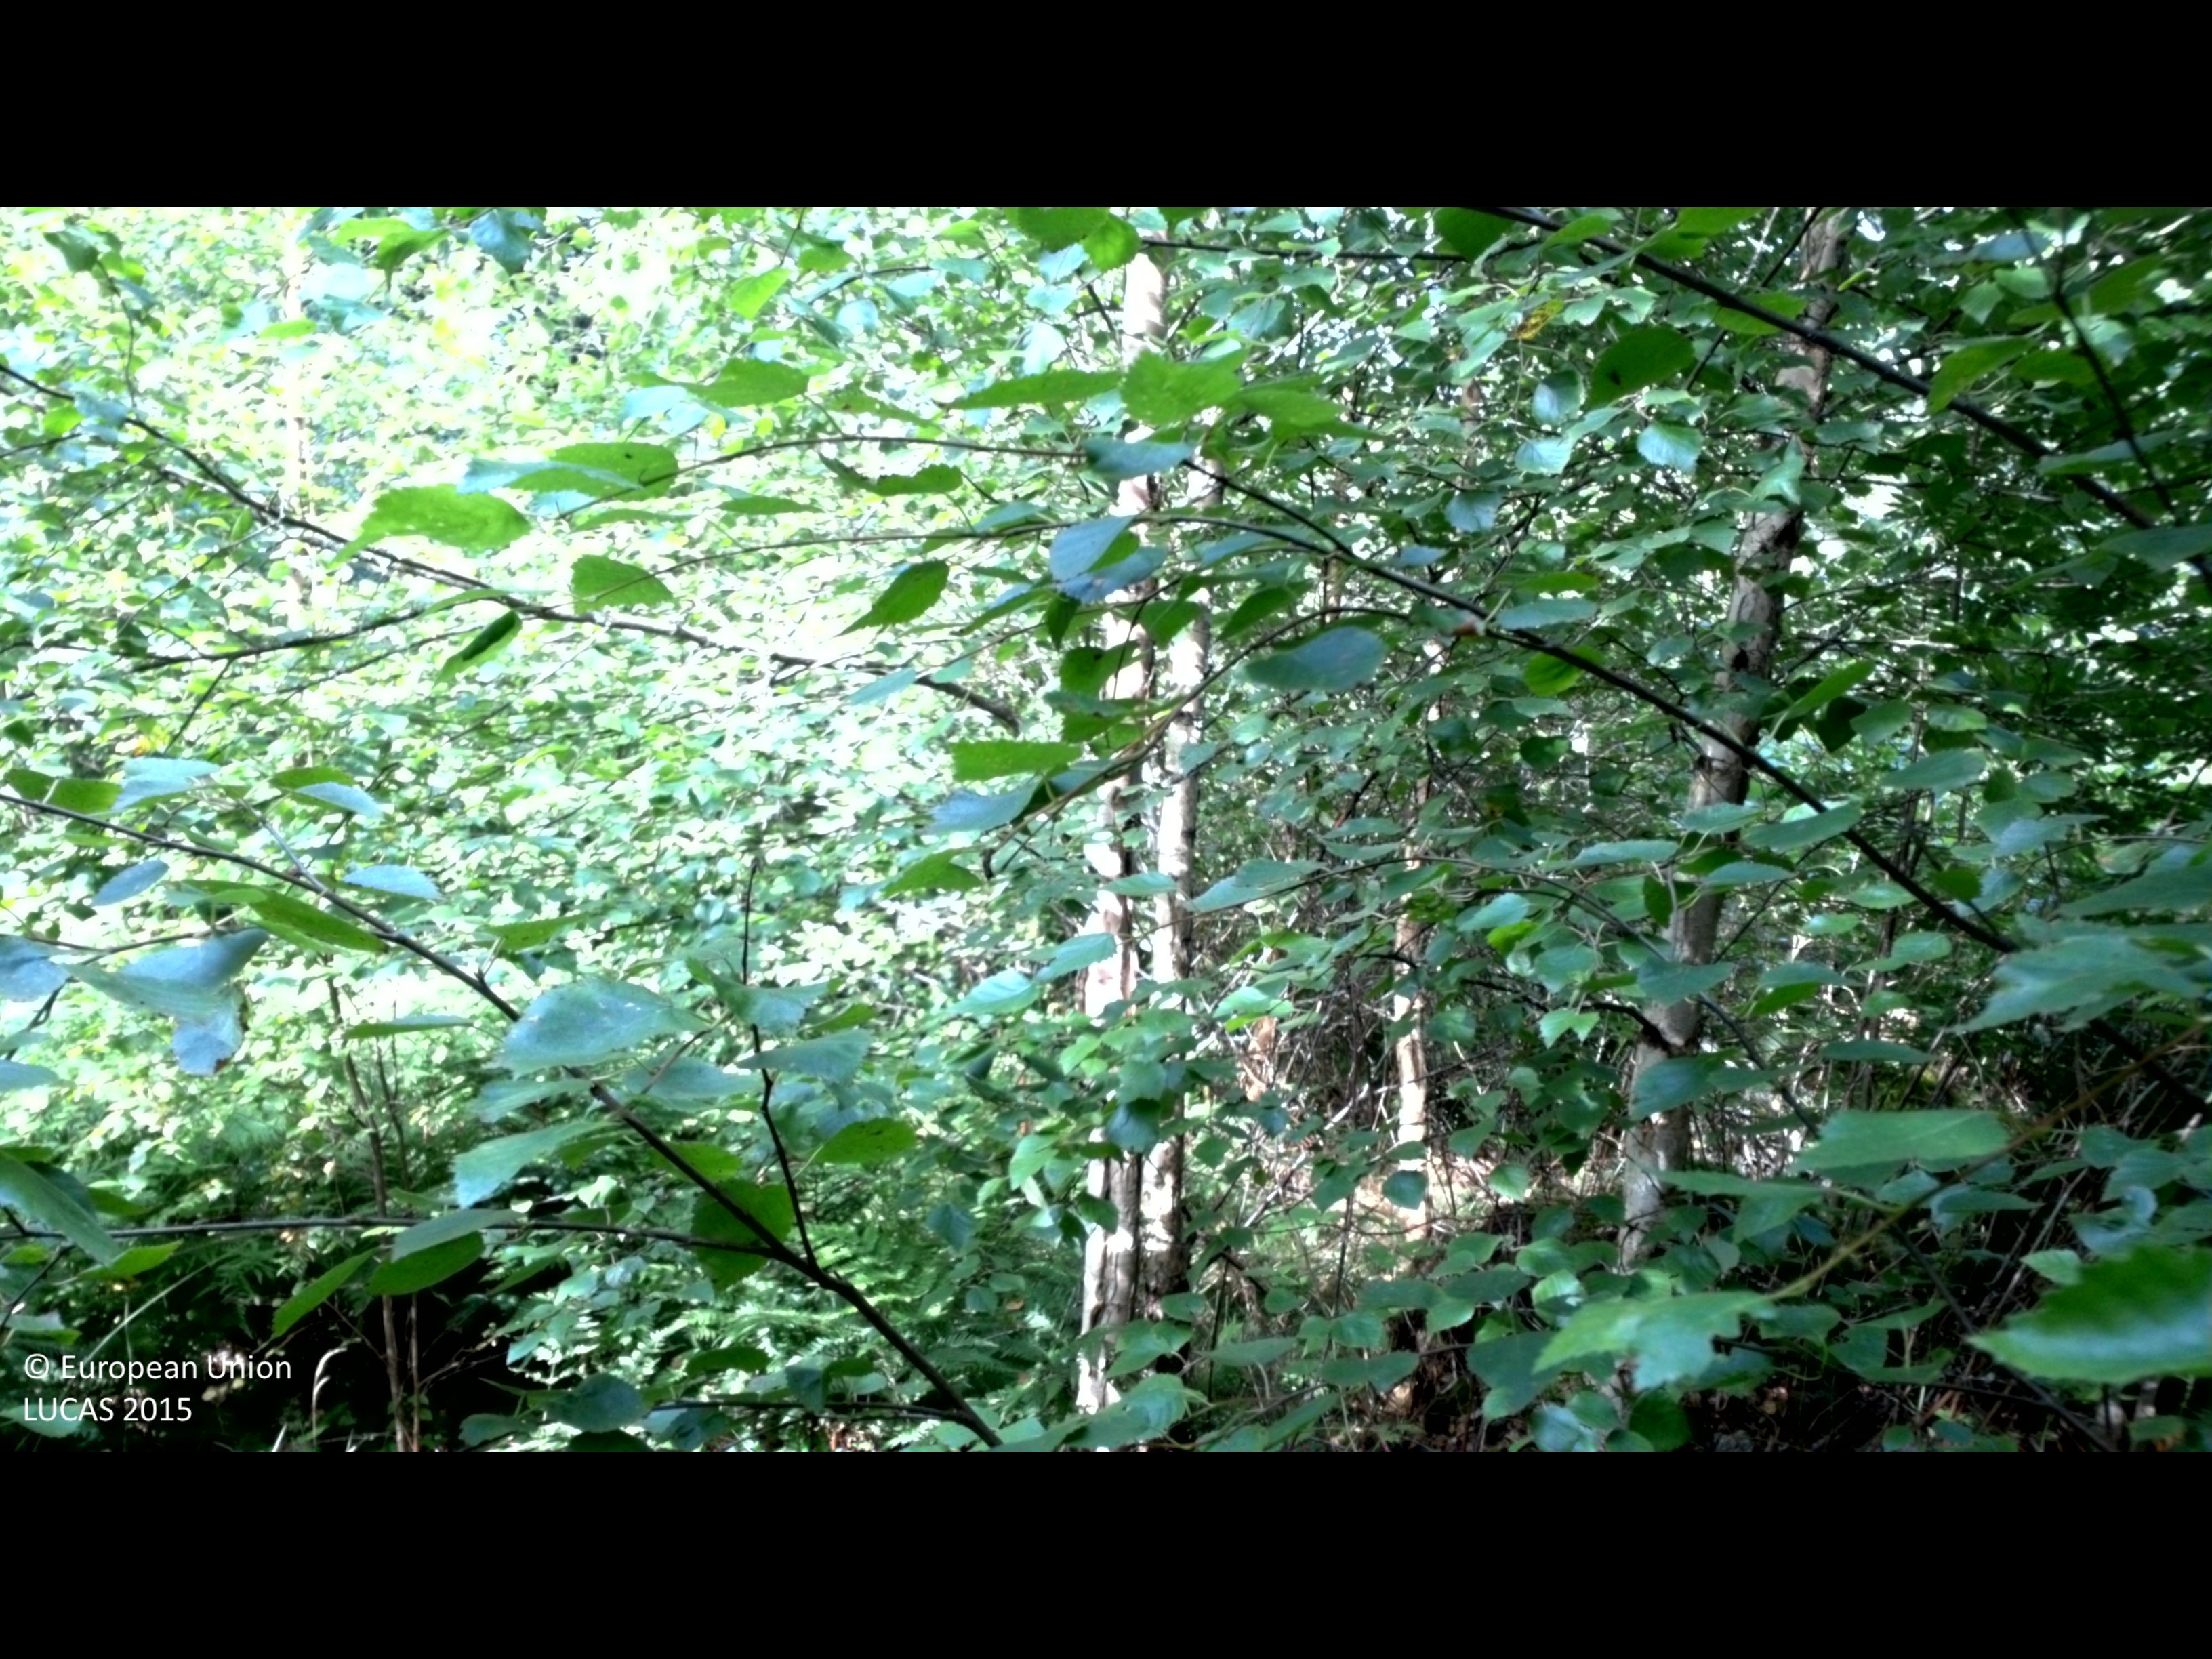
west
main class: Woodland
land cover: Broadleaved woodland
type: boreal forest
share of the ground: > 75 %
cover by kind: broadleaved forest trees 85 %, shrubs 10 %, herbaceous plants 5 %
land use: Forestry
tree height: < 5 m
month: August
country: SE
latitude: 56.4031
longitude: 14.3239
